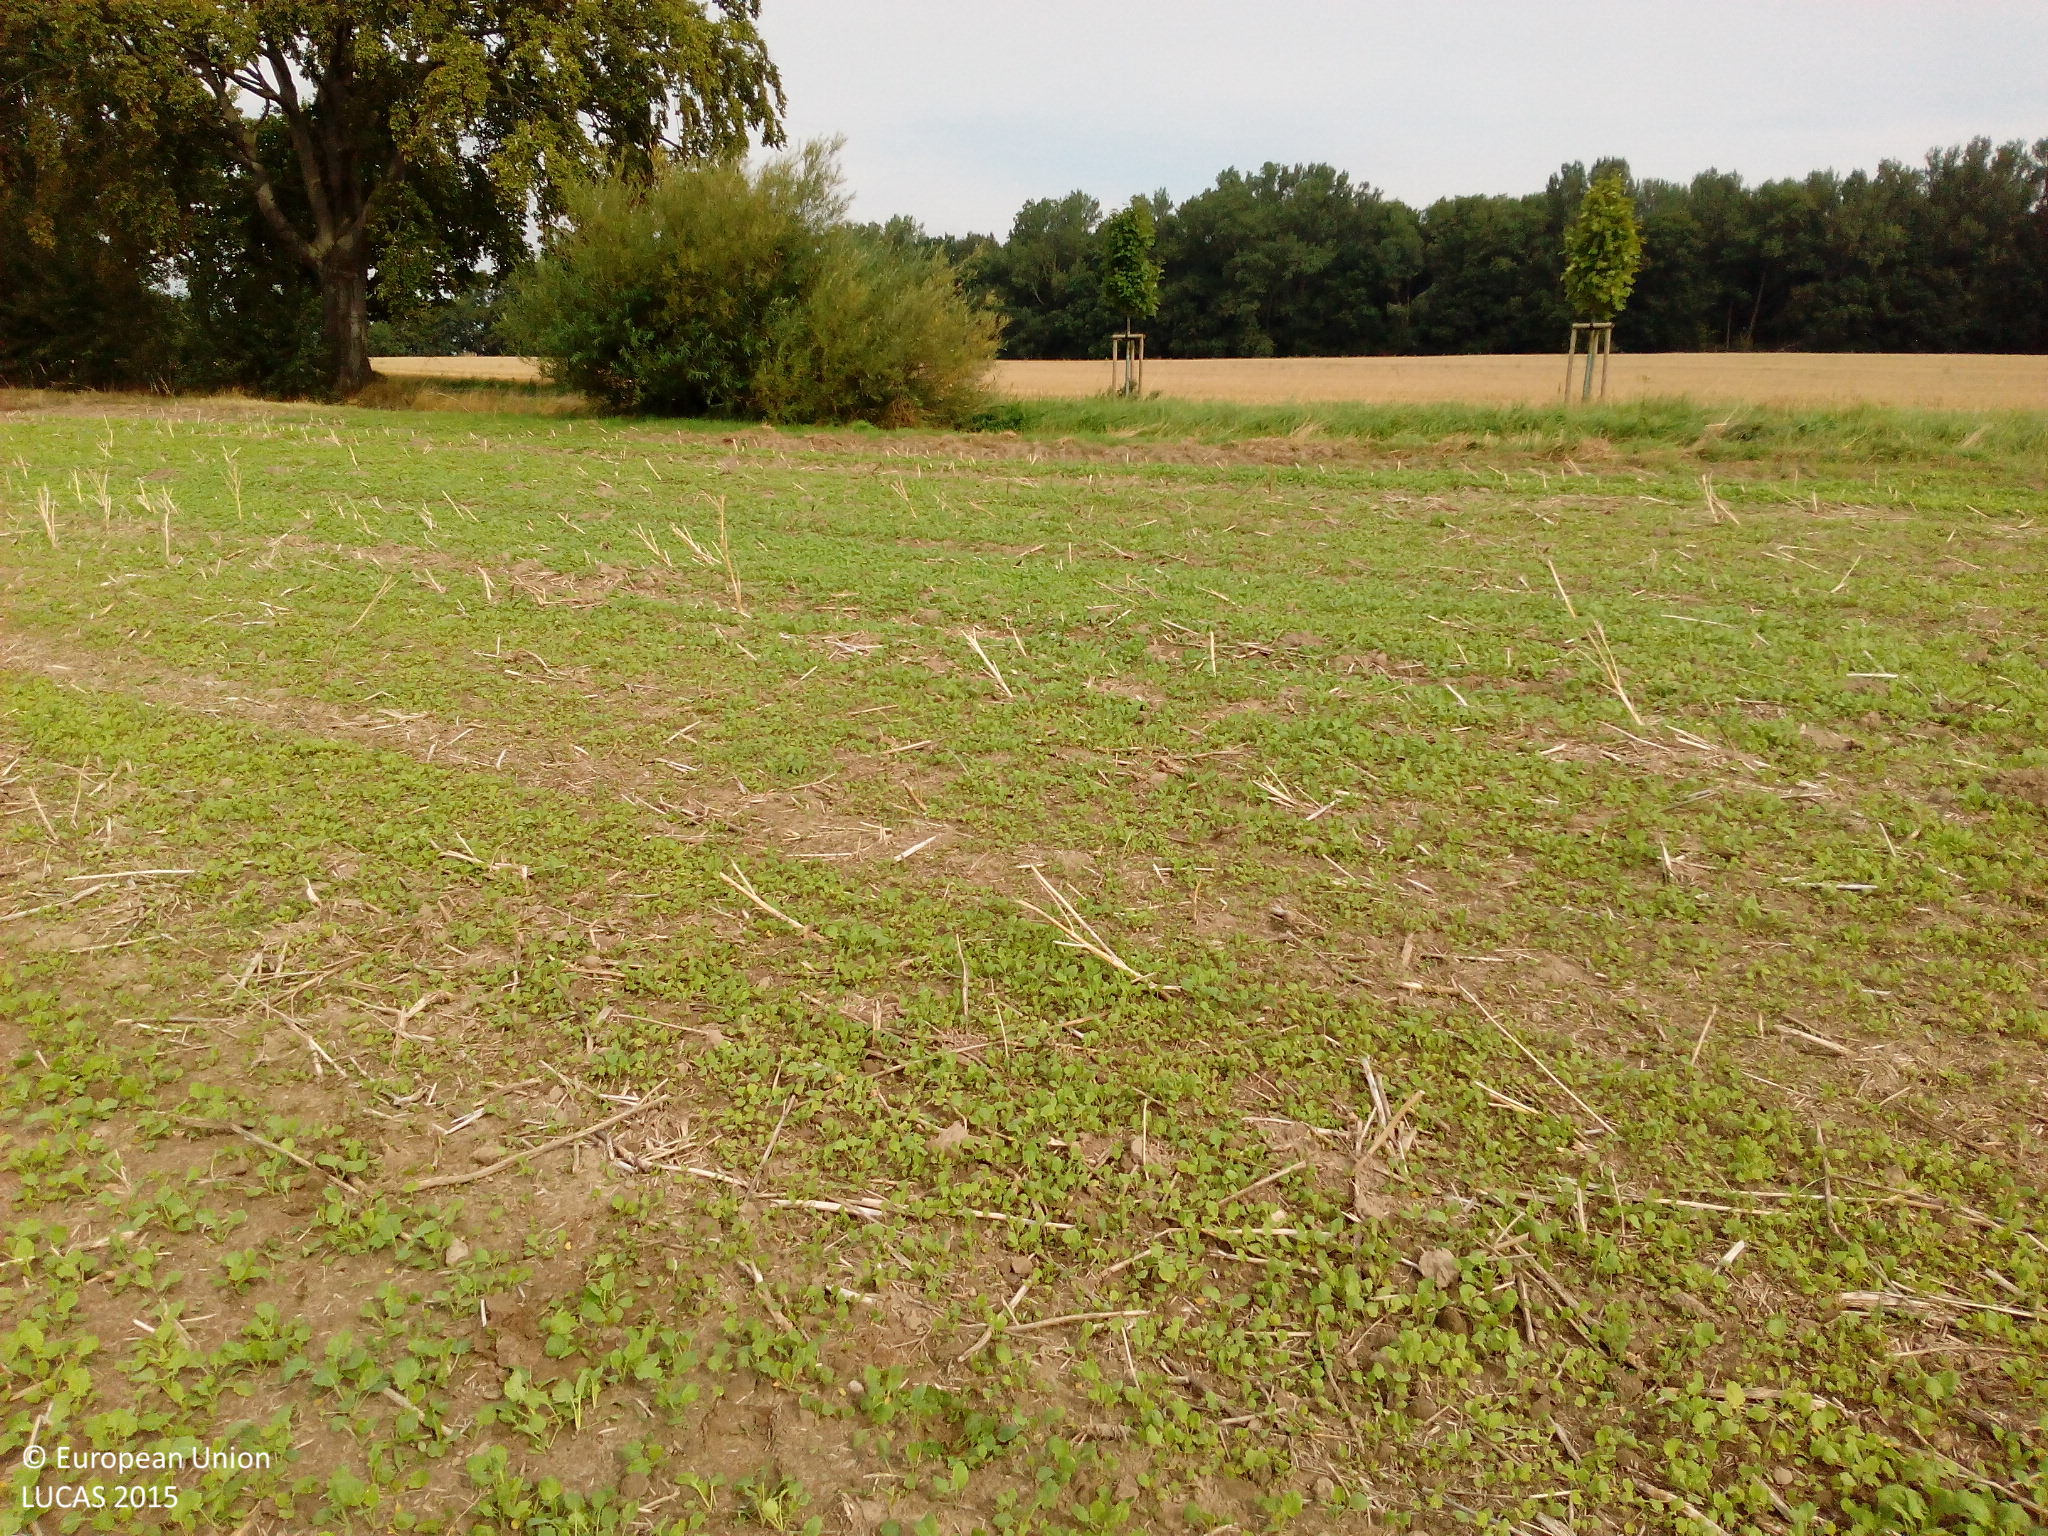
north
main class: Cropland
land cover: Rape and turnip rape
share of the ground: 25 - 50 %
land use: Agriculture (excluding fallow land and kitchen gardens)
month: September
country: DE
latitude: 54.2219
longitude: 12.4683
